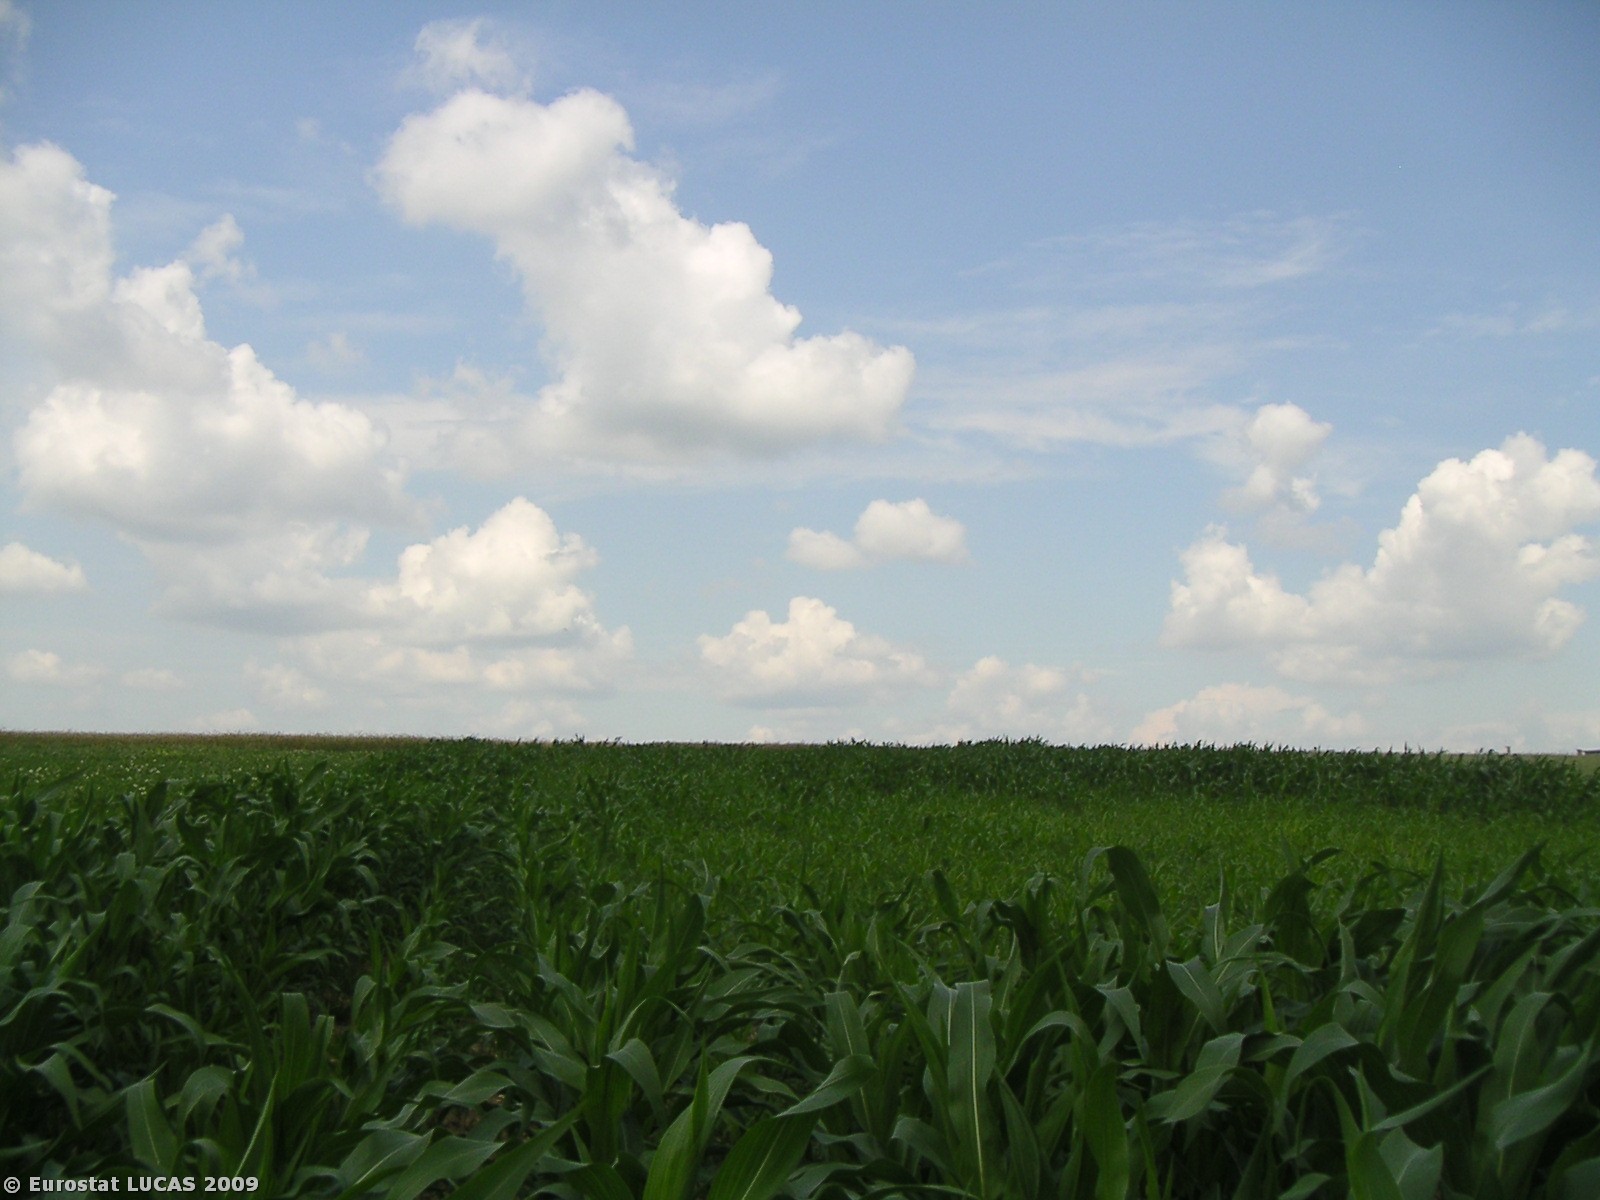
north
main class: Cropland
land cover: Maize
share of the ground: > 75 %
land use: Agriculture (excluding fallow land and kitchen gardens)
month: July
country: PL
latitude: 50.5085
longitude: 19.7455
